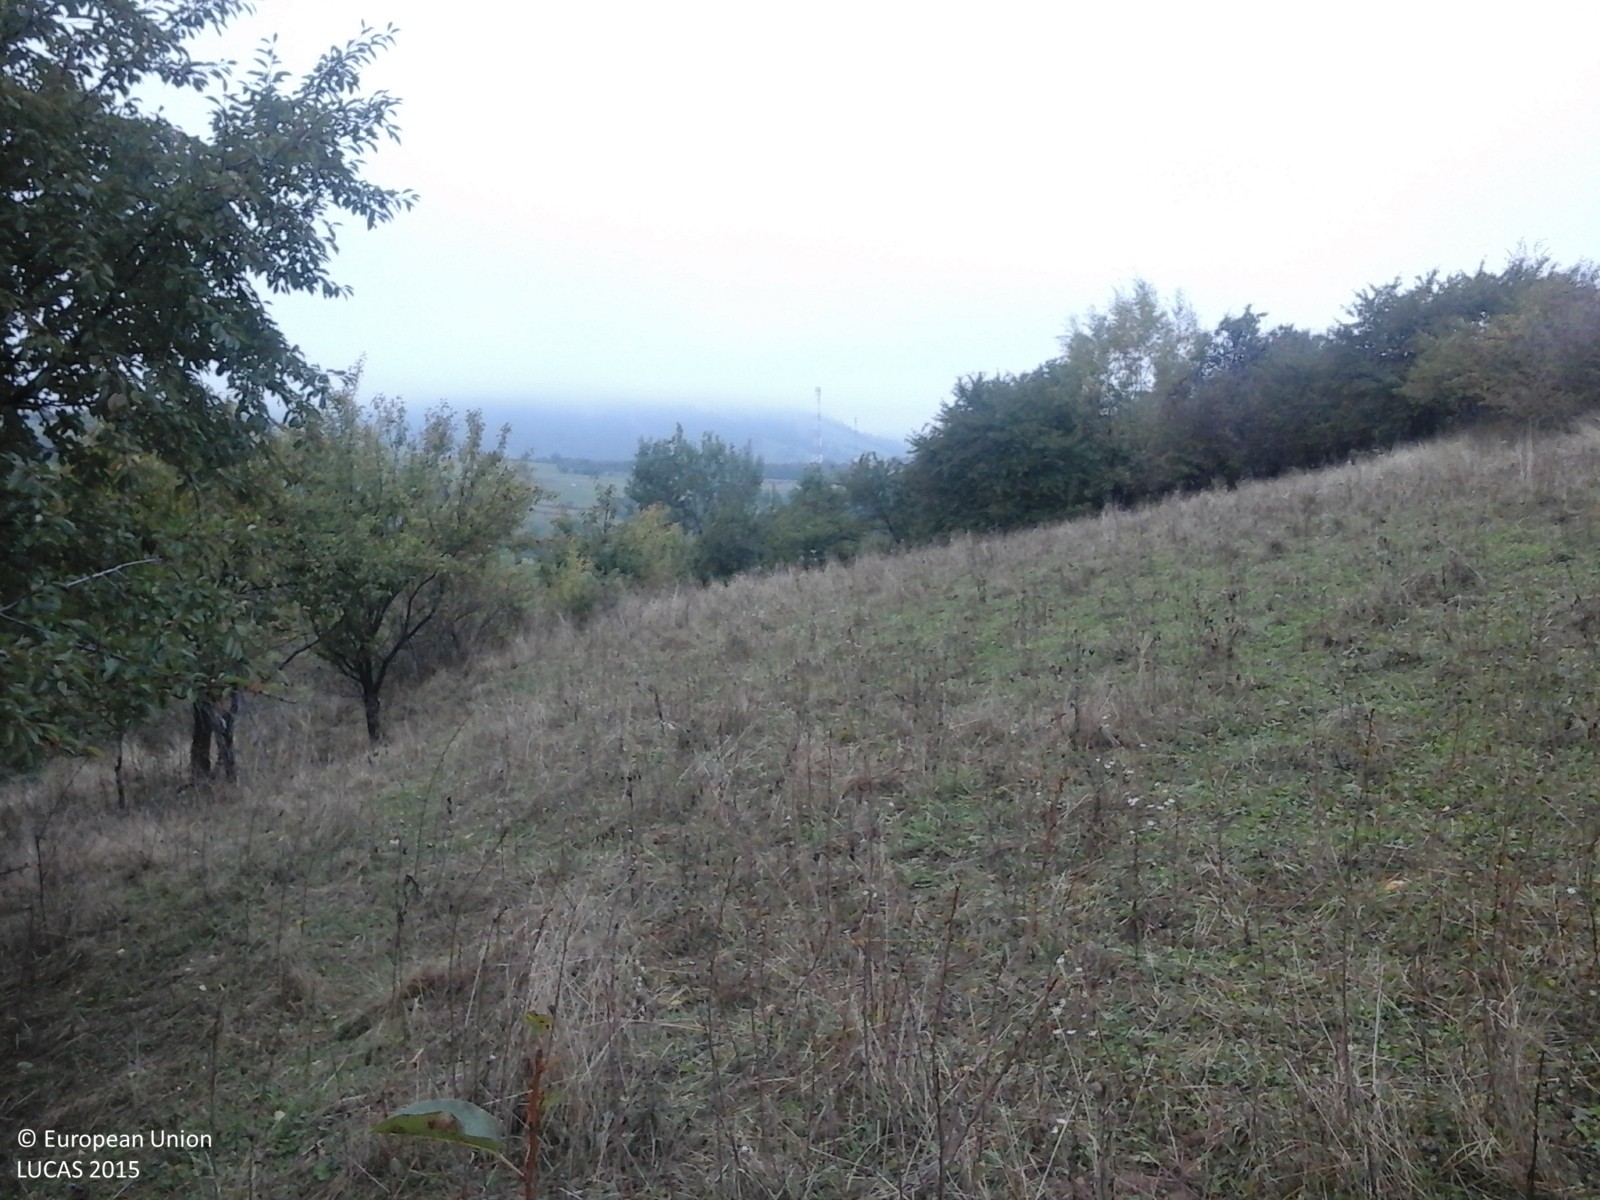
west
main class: Grassland
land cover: Spontaneously vegetated surfaces
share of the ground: > 75 %
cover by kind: herbaceous plants 100 %
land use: Fallow land
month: October
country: RO
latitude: 45.7057
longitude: 24.0864
